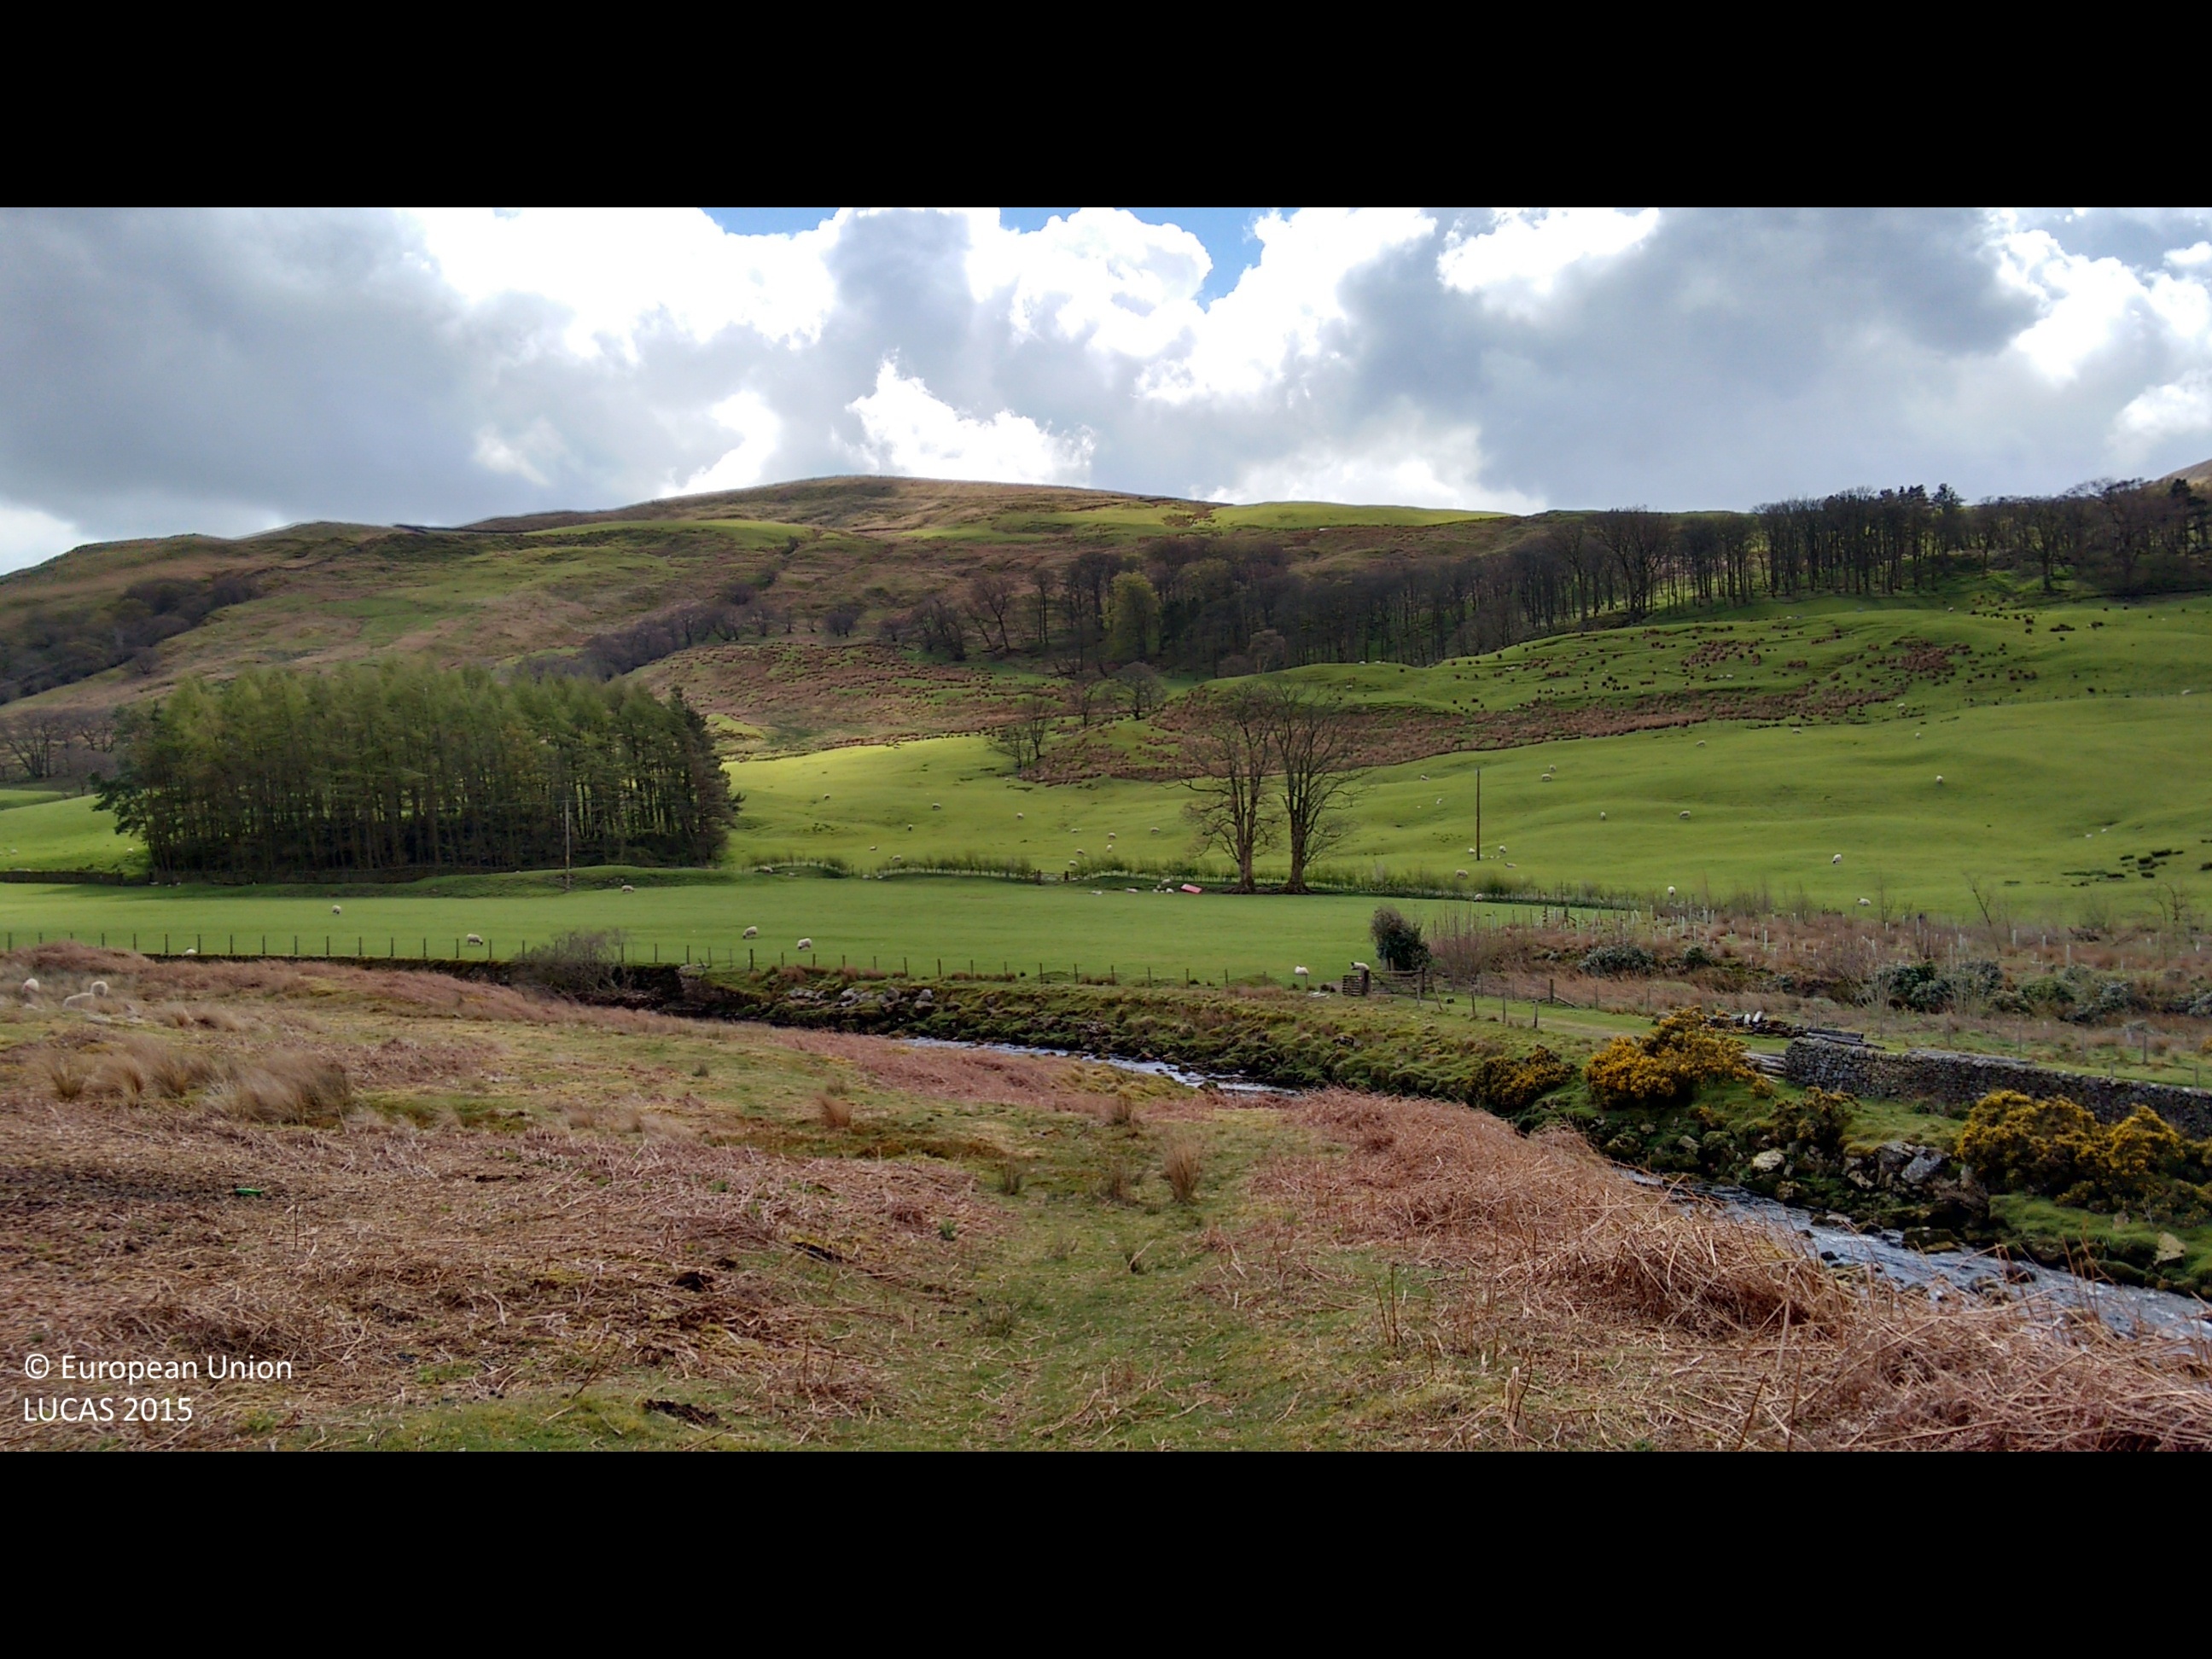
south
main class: Grassland
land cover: Grassland without tree/shrub cover
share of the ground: > 75 %
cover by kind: herbaceous plants 100 %
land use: Agriculture (excluding fallow land and kitchen gardens)
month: April
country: GB
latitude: 53.9480
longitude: -2.5444
